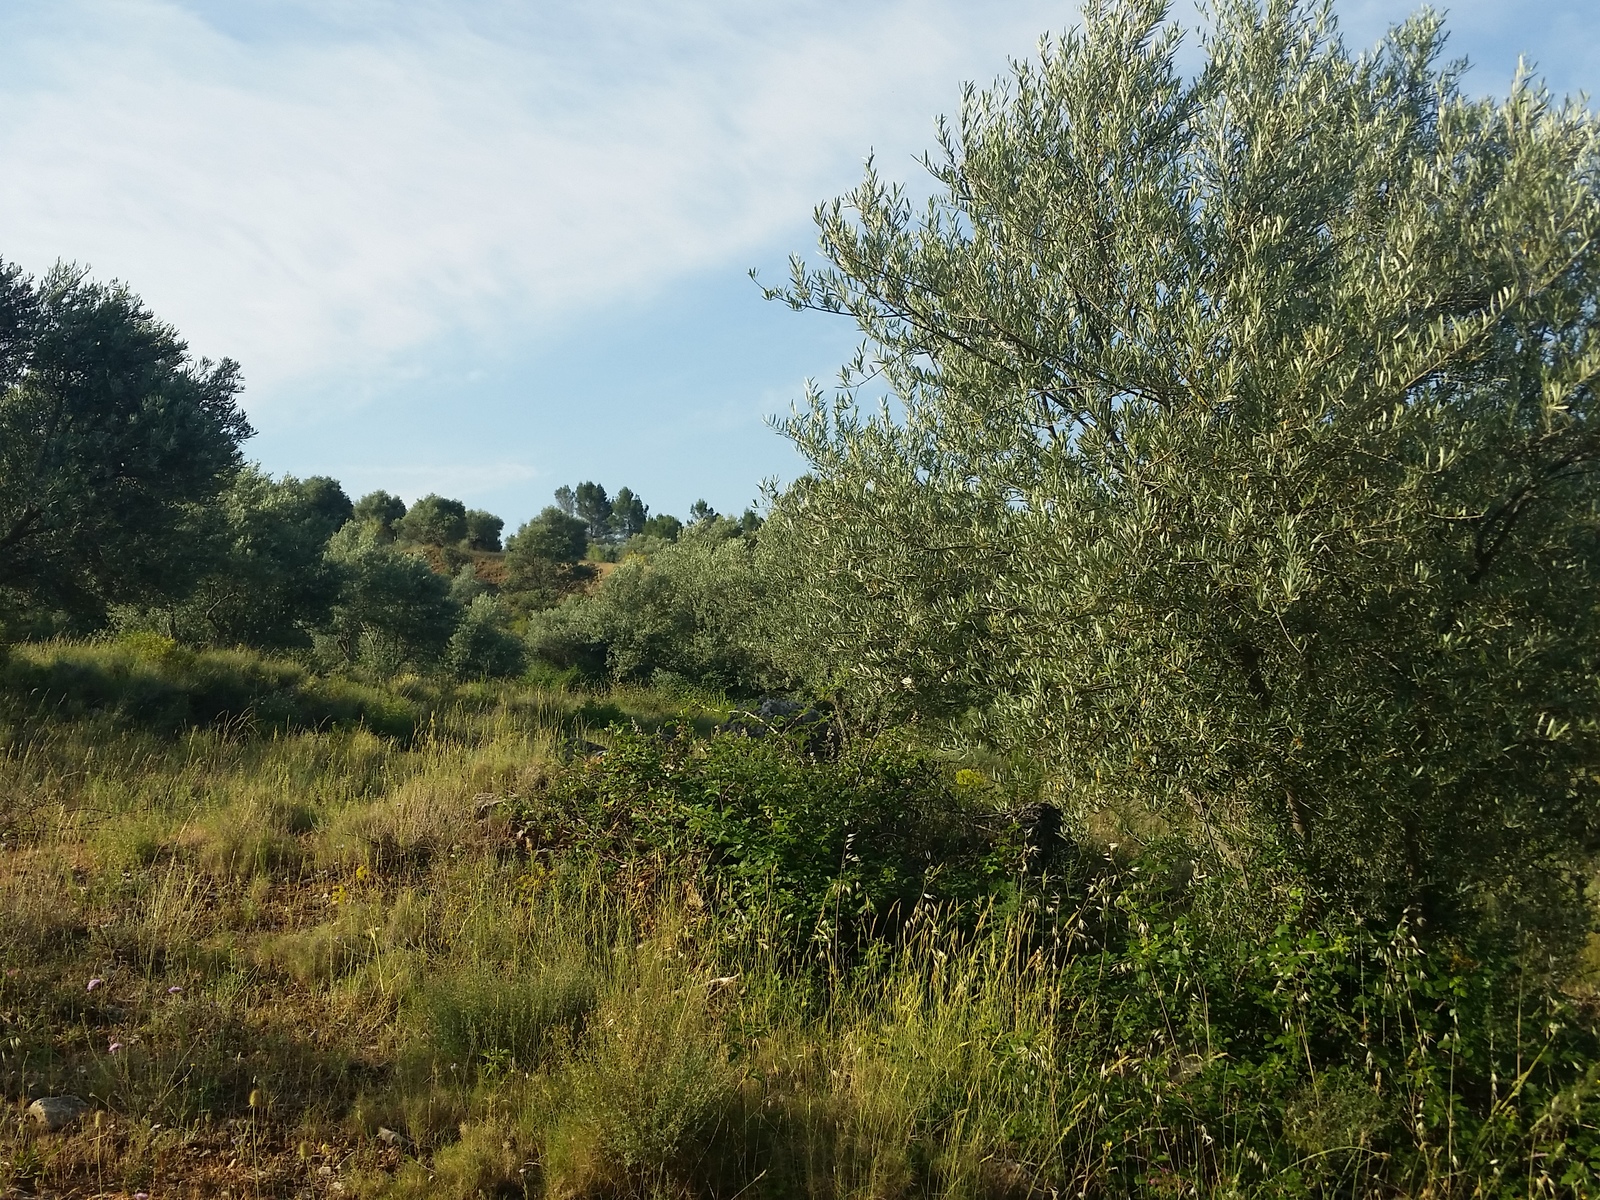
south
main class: Cropland
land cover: Olive groves
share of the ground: 25 - 50 %
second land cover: Grassland without tree/shrub cover
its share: 10 - 25 %
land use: Agriculture (excluding fallow land and kitchen gardens)
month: June
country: ES
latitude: 38.4372
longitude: -2.5202
